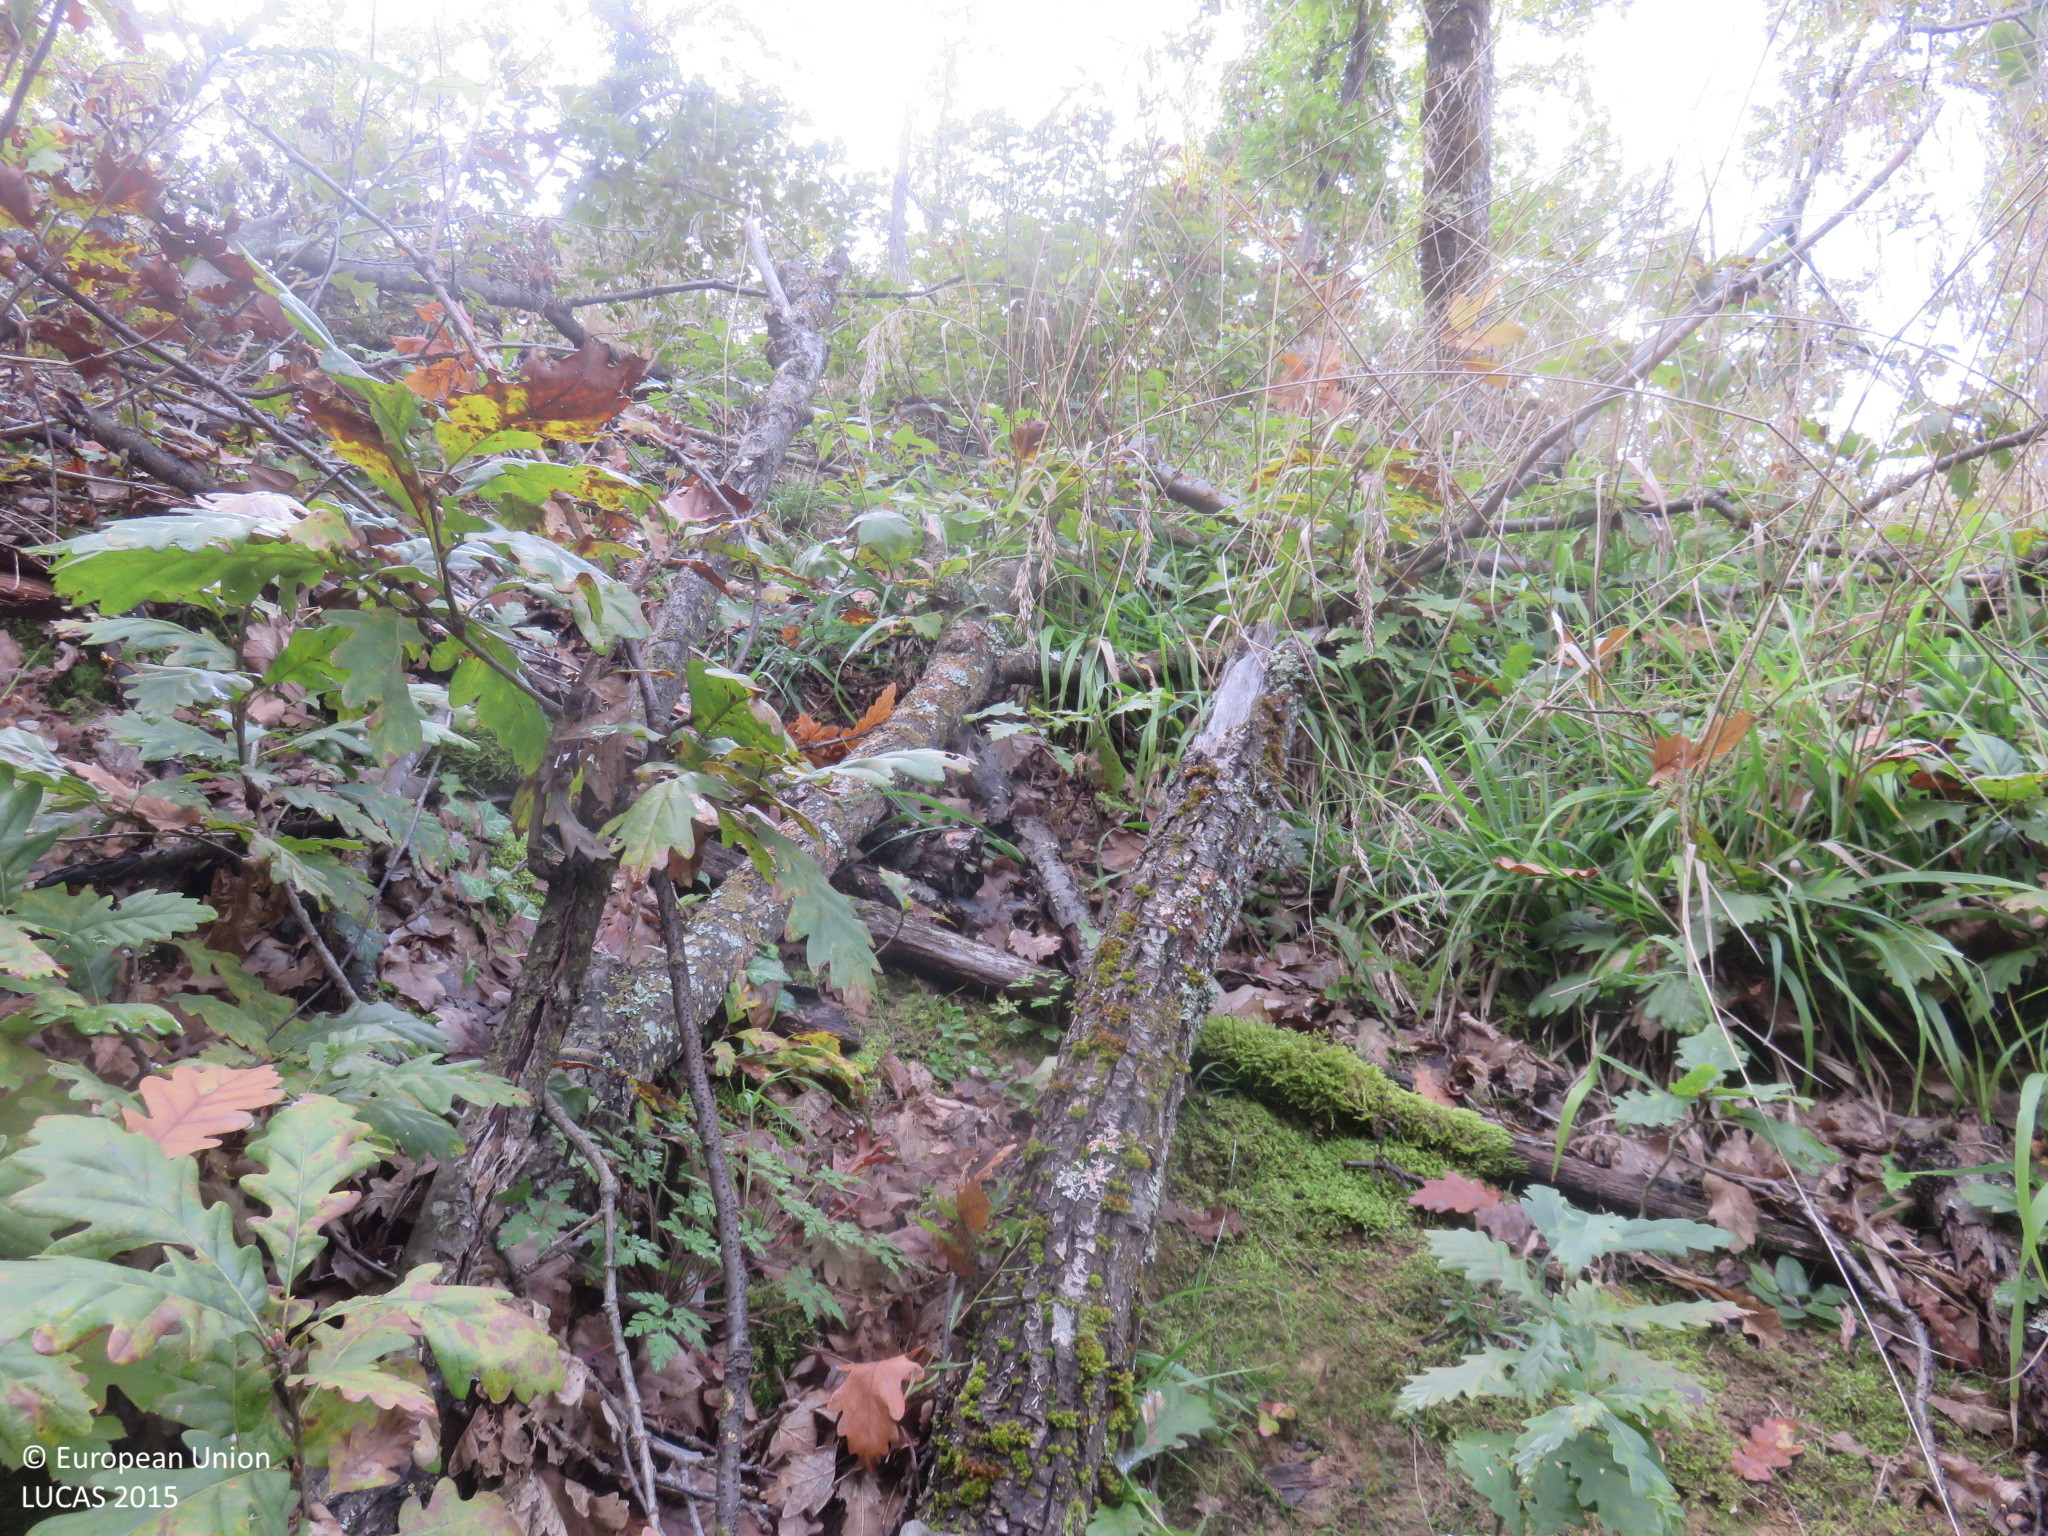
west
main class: Woodland
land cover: Broadleaved woodland
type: mesophytic deciduous forest
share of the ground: > 75 %
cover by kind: broadleaved forest trees 90 %, herbaceous plants 5 %, unconsolidated bare surface 5 %
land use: Forestry
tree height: < 5 m
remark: Clear cut
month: October
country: BG
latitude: 42.9231
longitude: 24.9995
